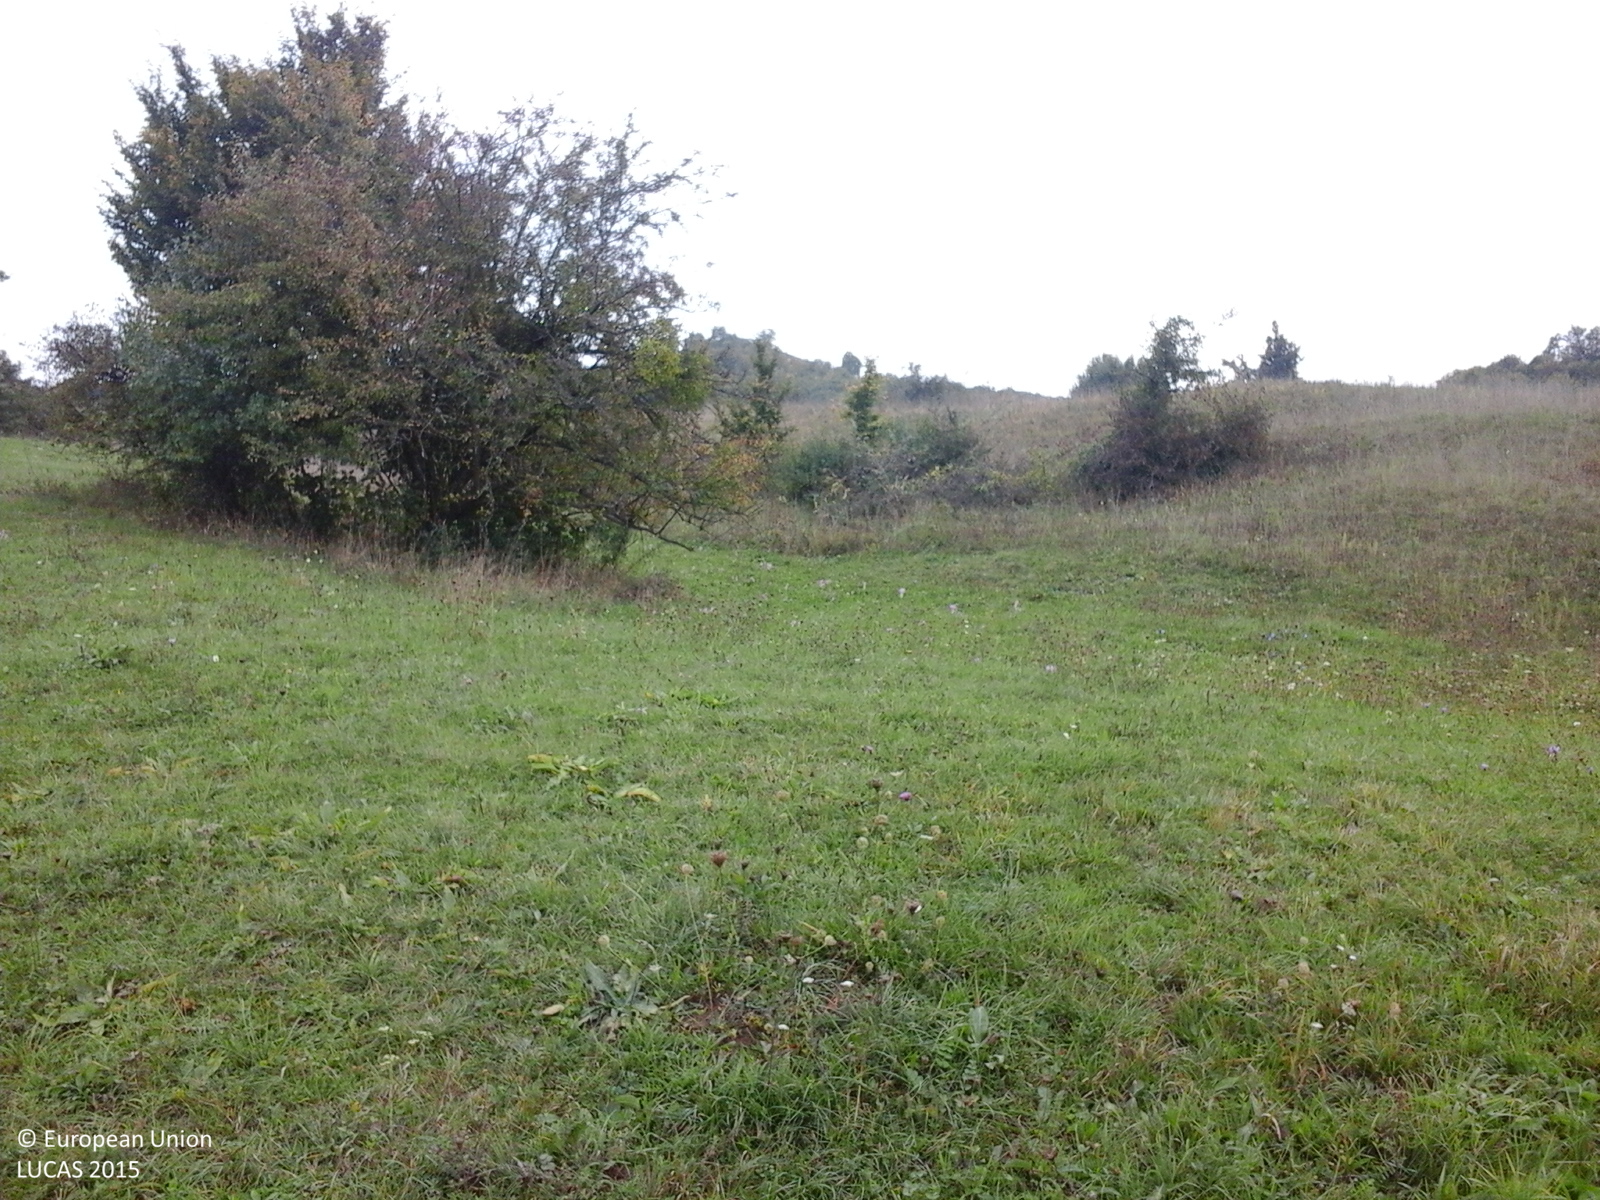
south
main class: Grassland
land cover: Grassland without tree/shrub cover
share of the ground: > 75 %
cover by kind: herbaceous plants 100 %
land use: Agriculture (excluding fallow land and kitchen gardens)
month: October
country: RO
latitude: 46.2601
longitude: 24.8429
